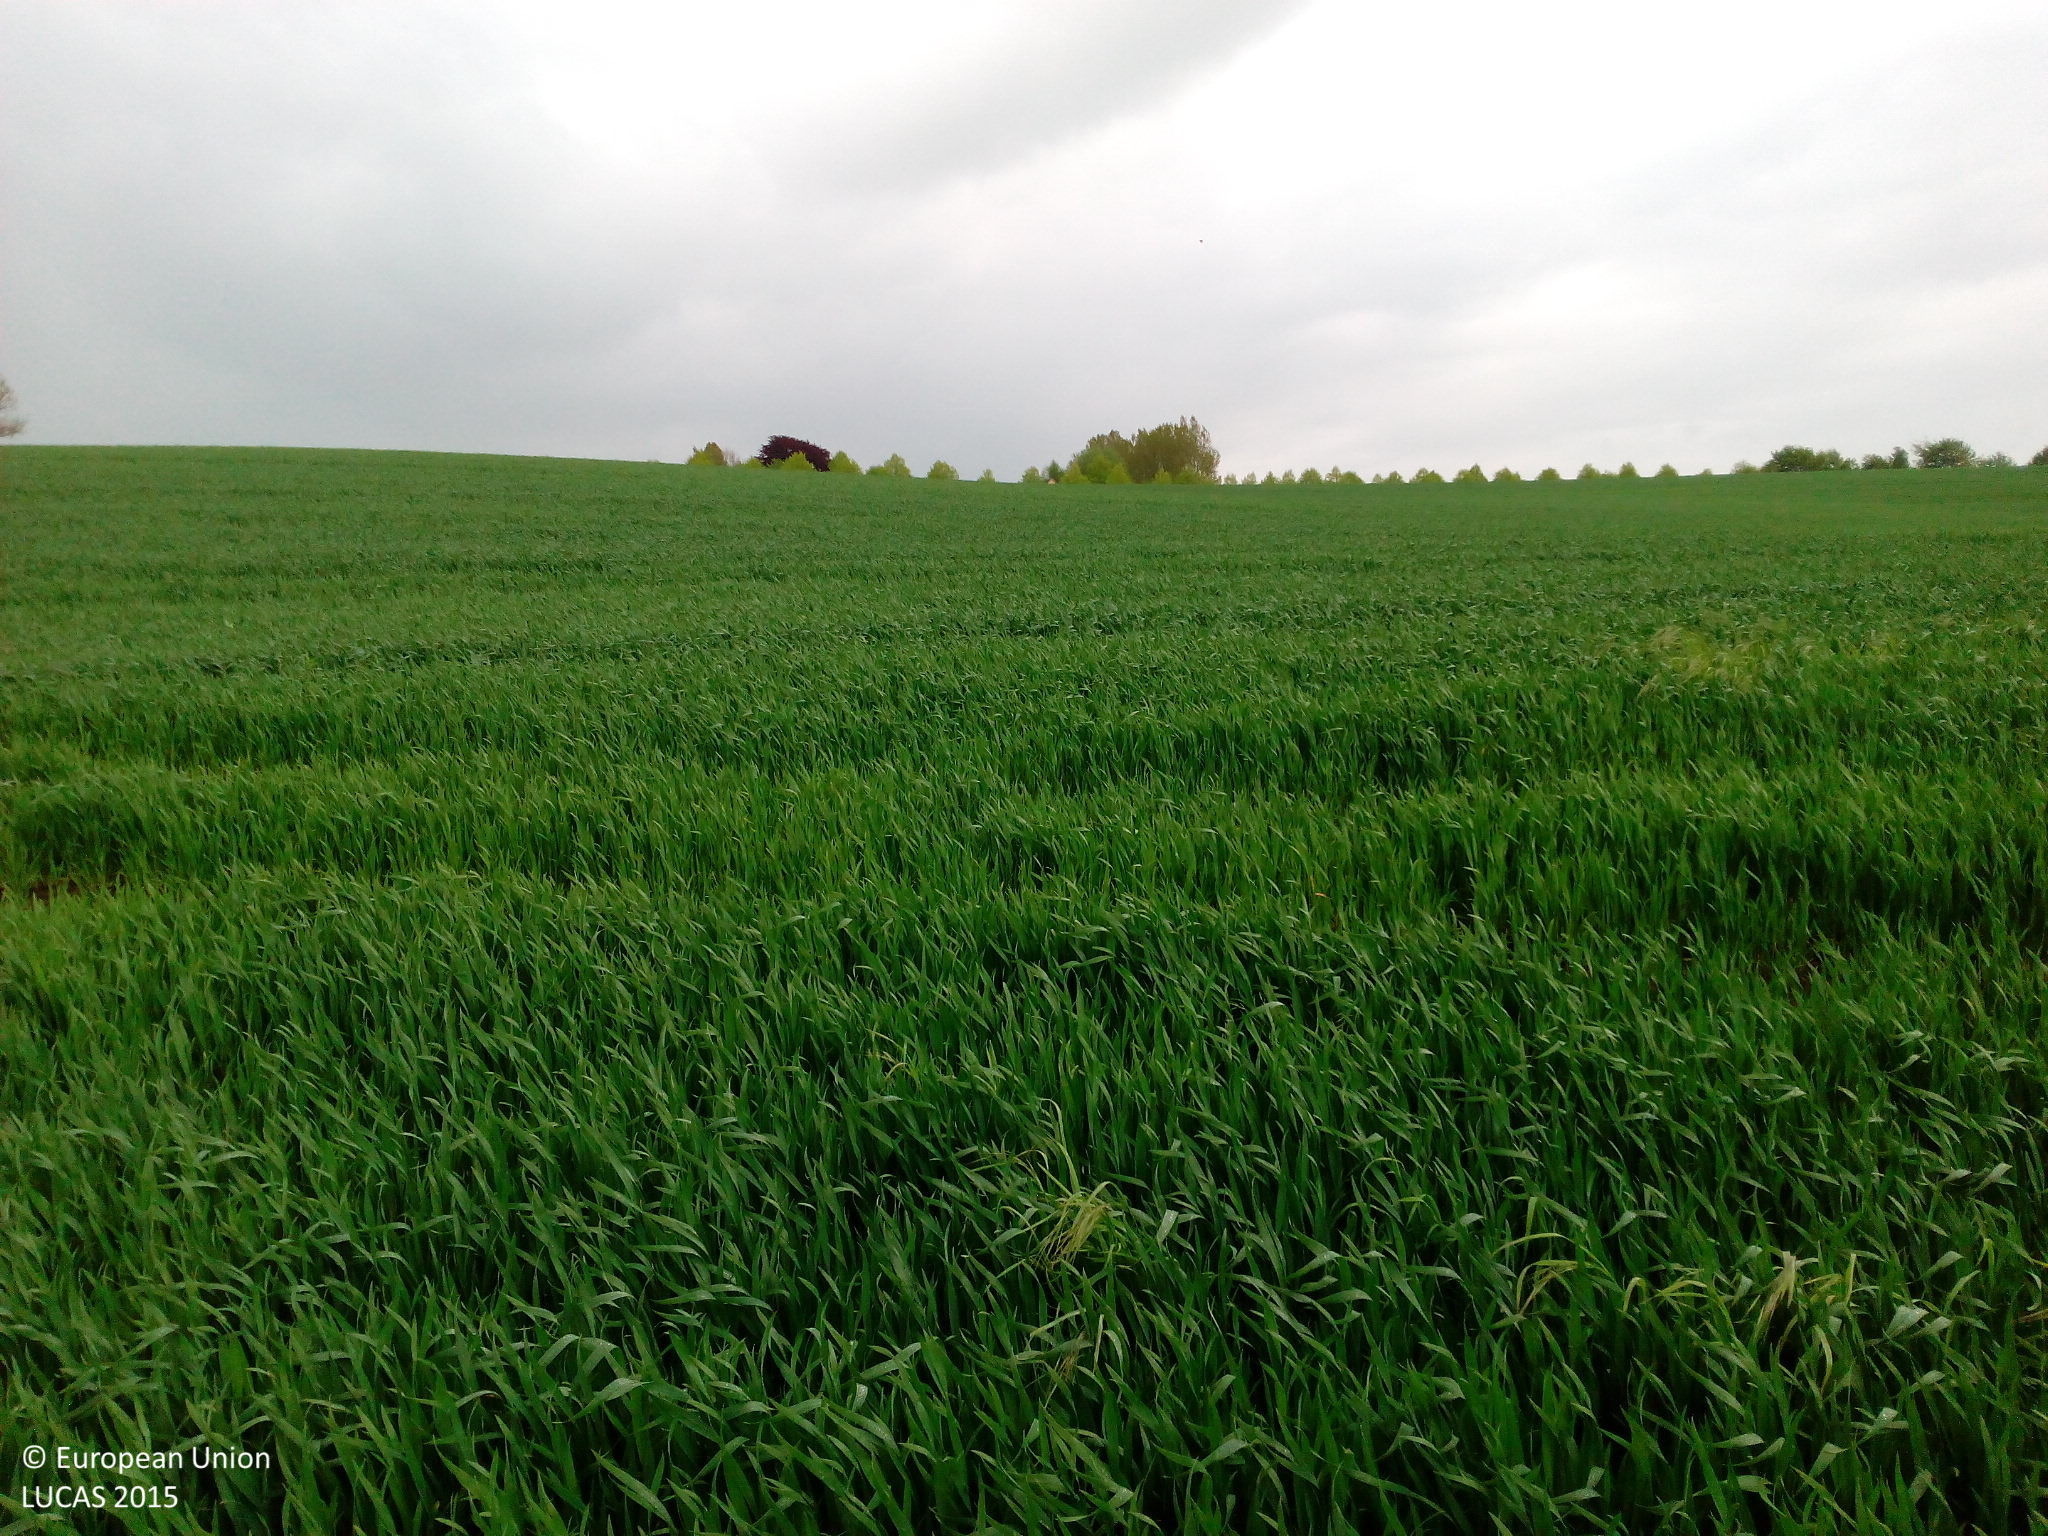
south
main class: Cropland
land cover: Common wheat
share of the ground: > 75 %
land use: Agriculture (excluding fallow land and kitchen gardens)
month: May
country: DK
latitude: 55.6150
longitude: 11.9829
